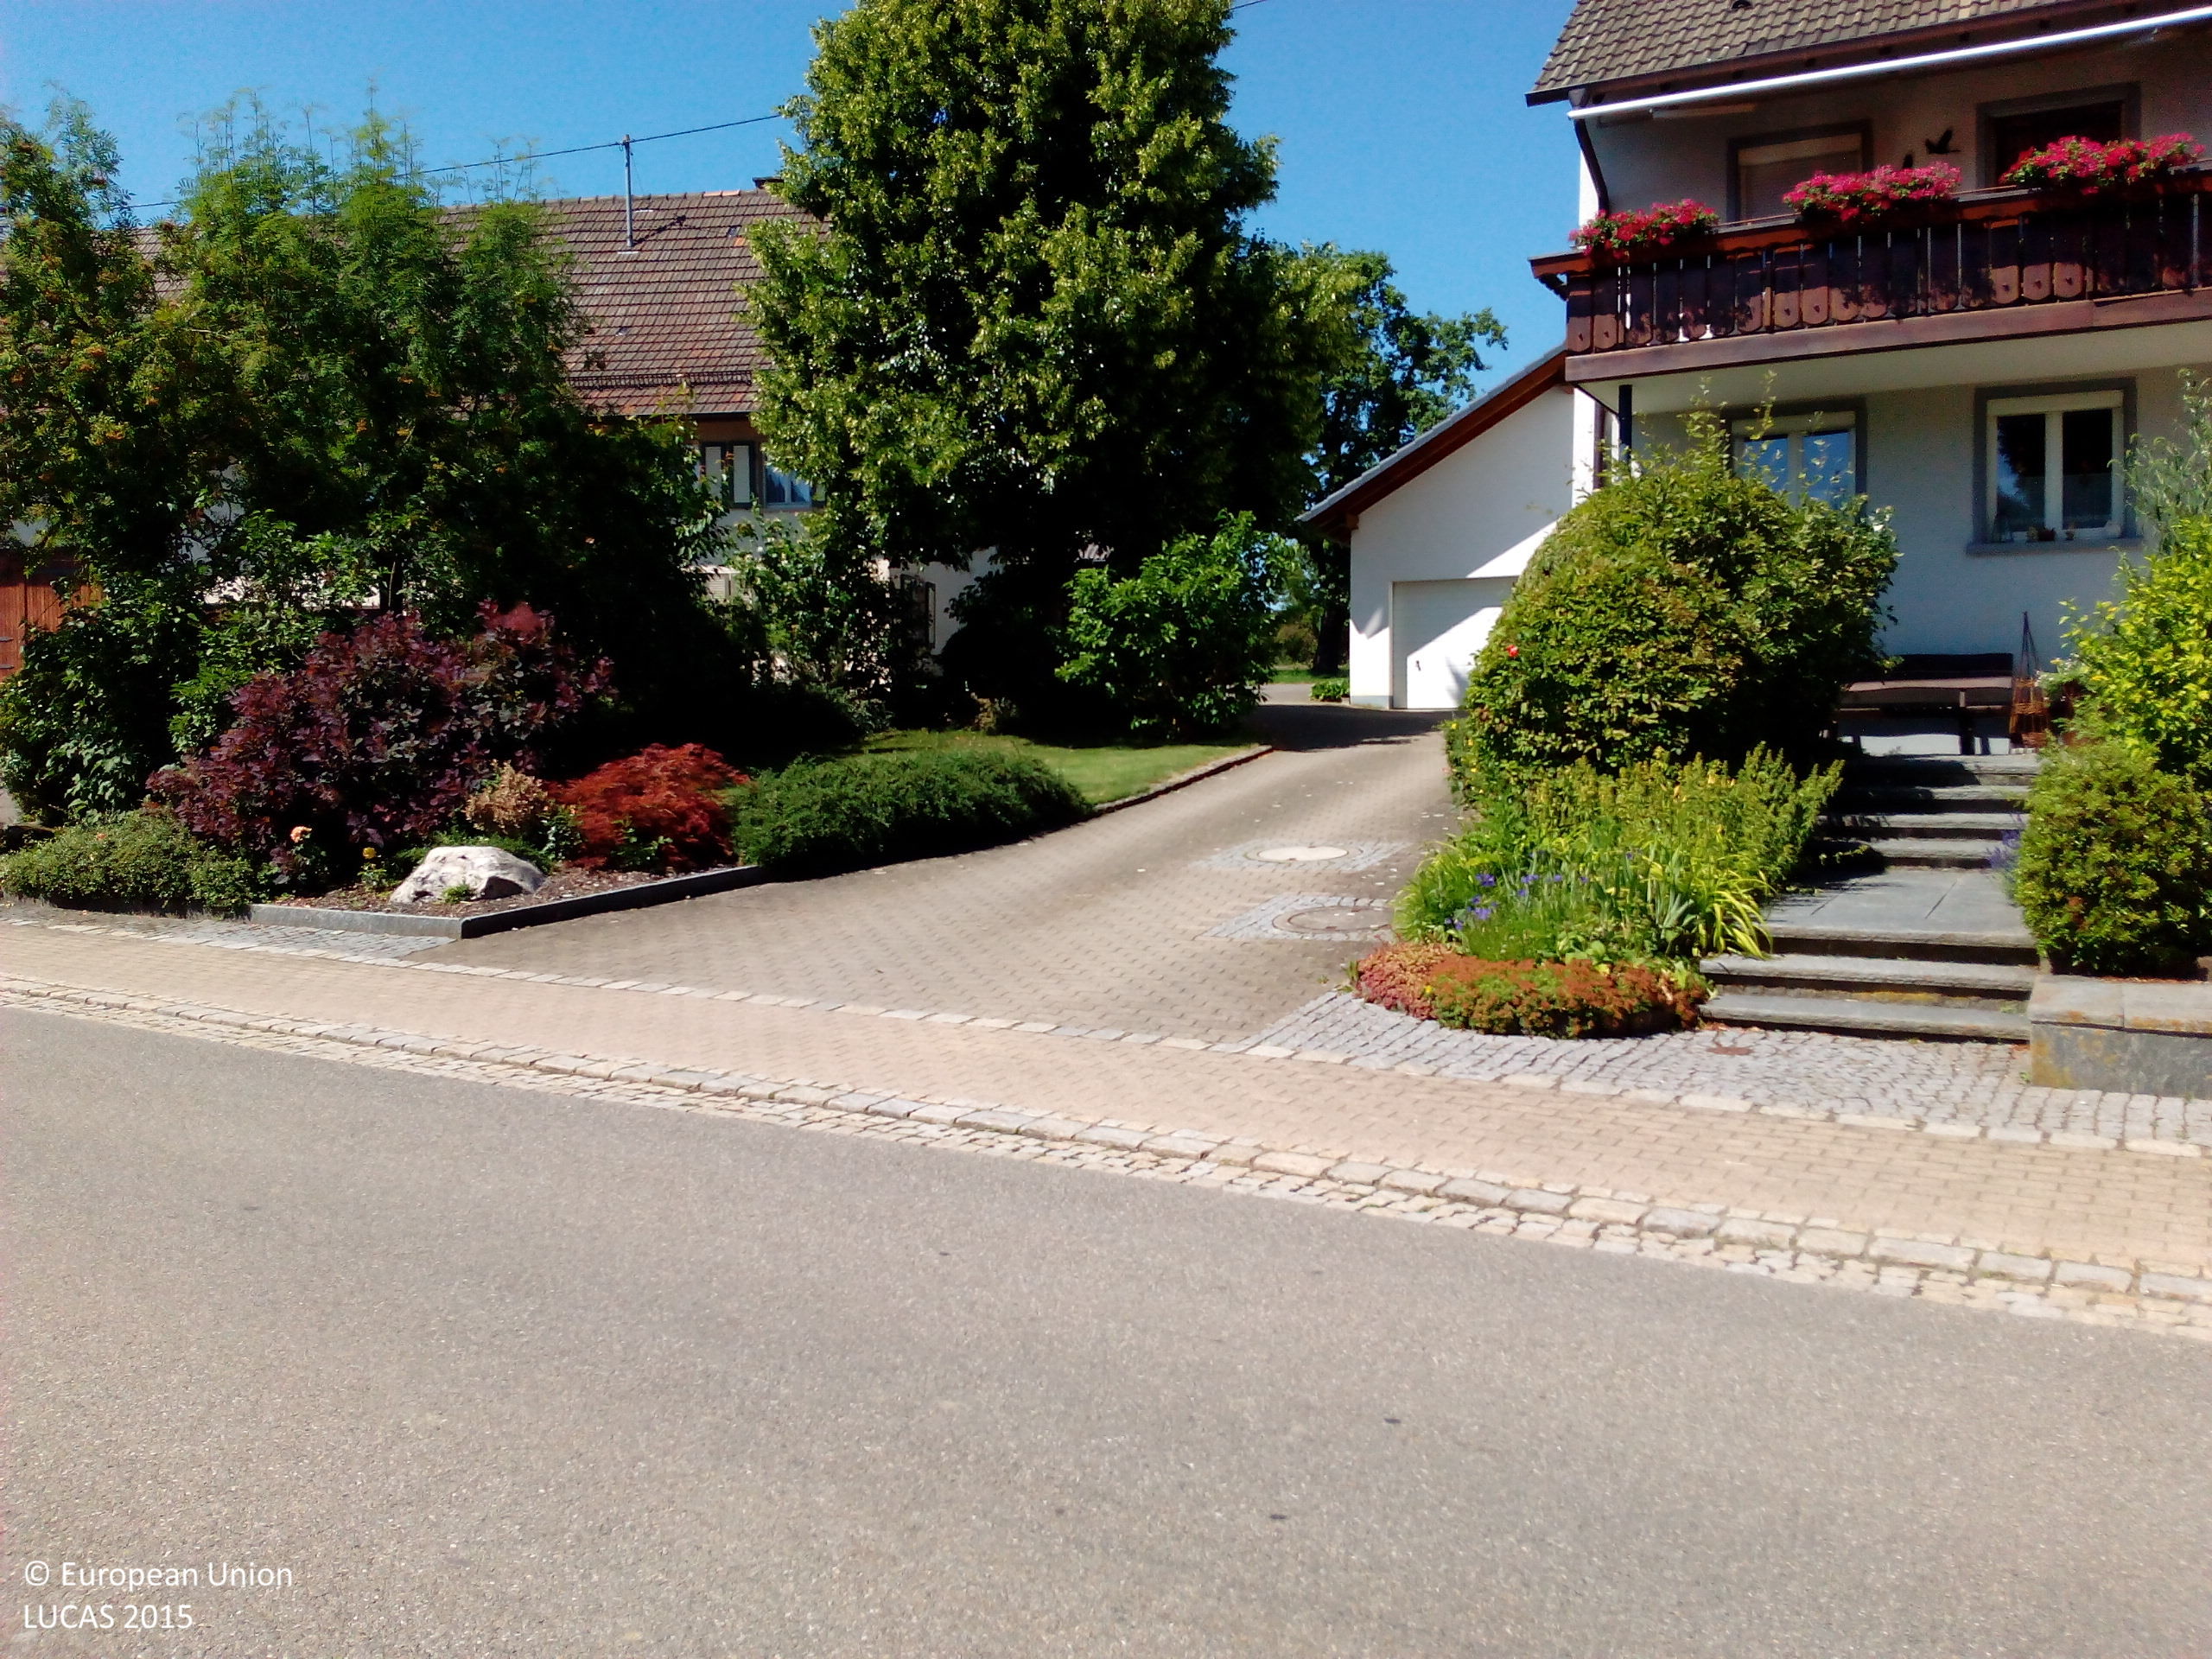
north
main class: Cropland
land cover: Pear fruit
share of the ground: 25 - 50 %
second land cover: Grassland without tree/shrub cover
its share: > 75 %
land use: Kitchen garden
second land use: Residential
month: July
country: DE
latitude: 47.8200
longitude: 8.7054
